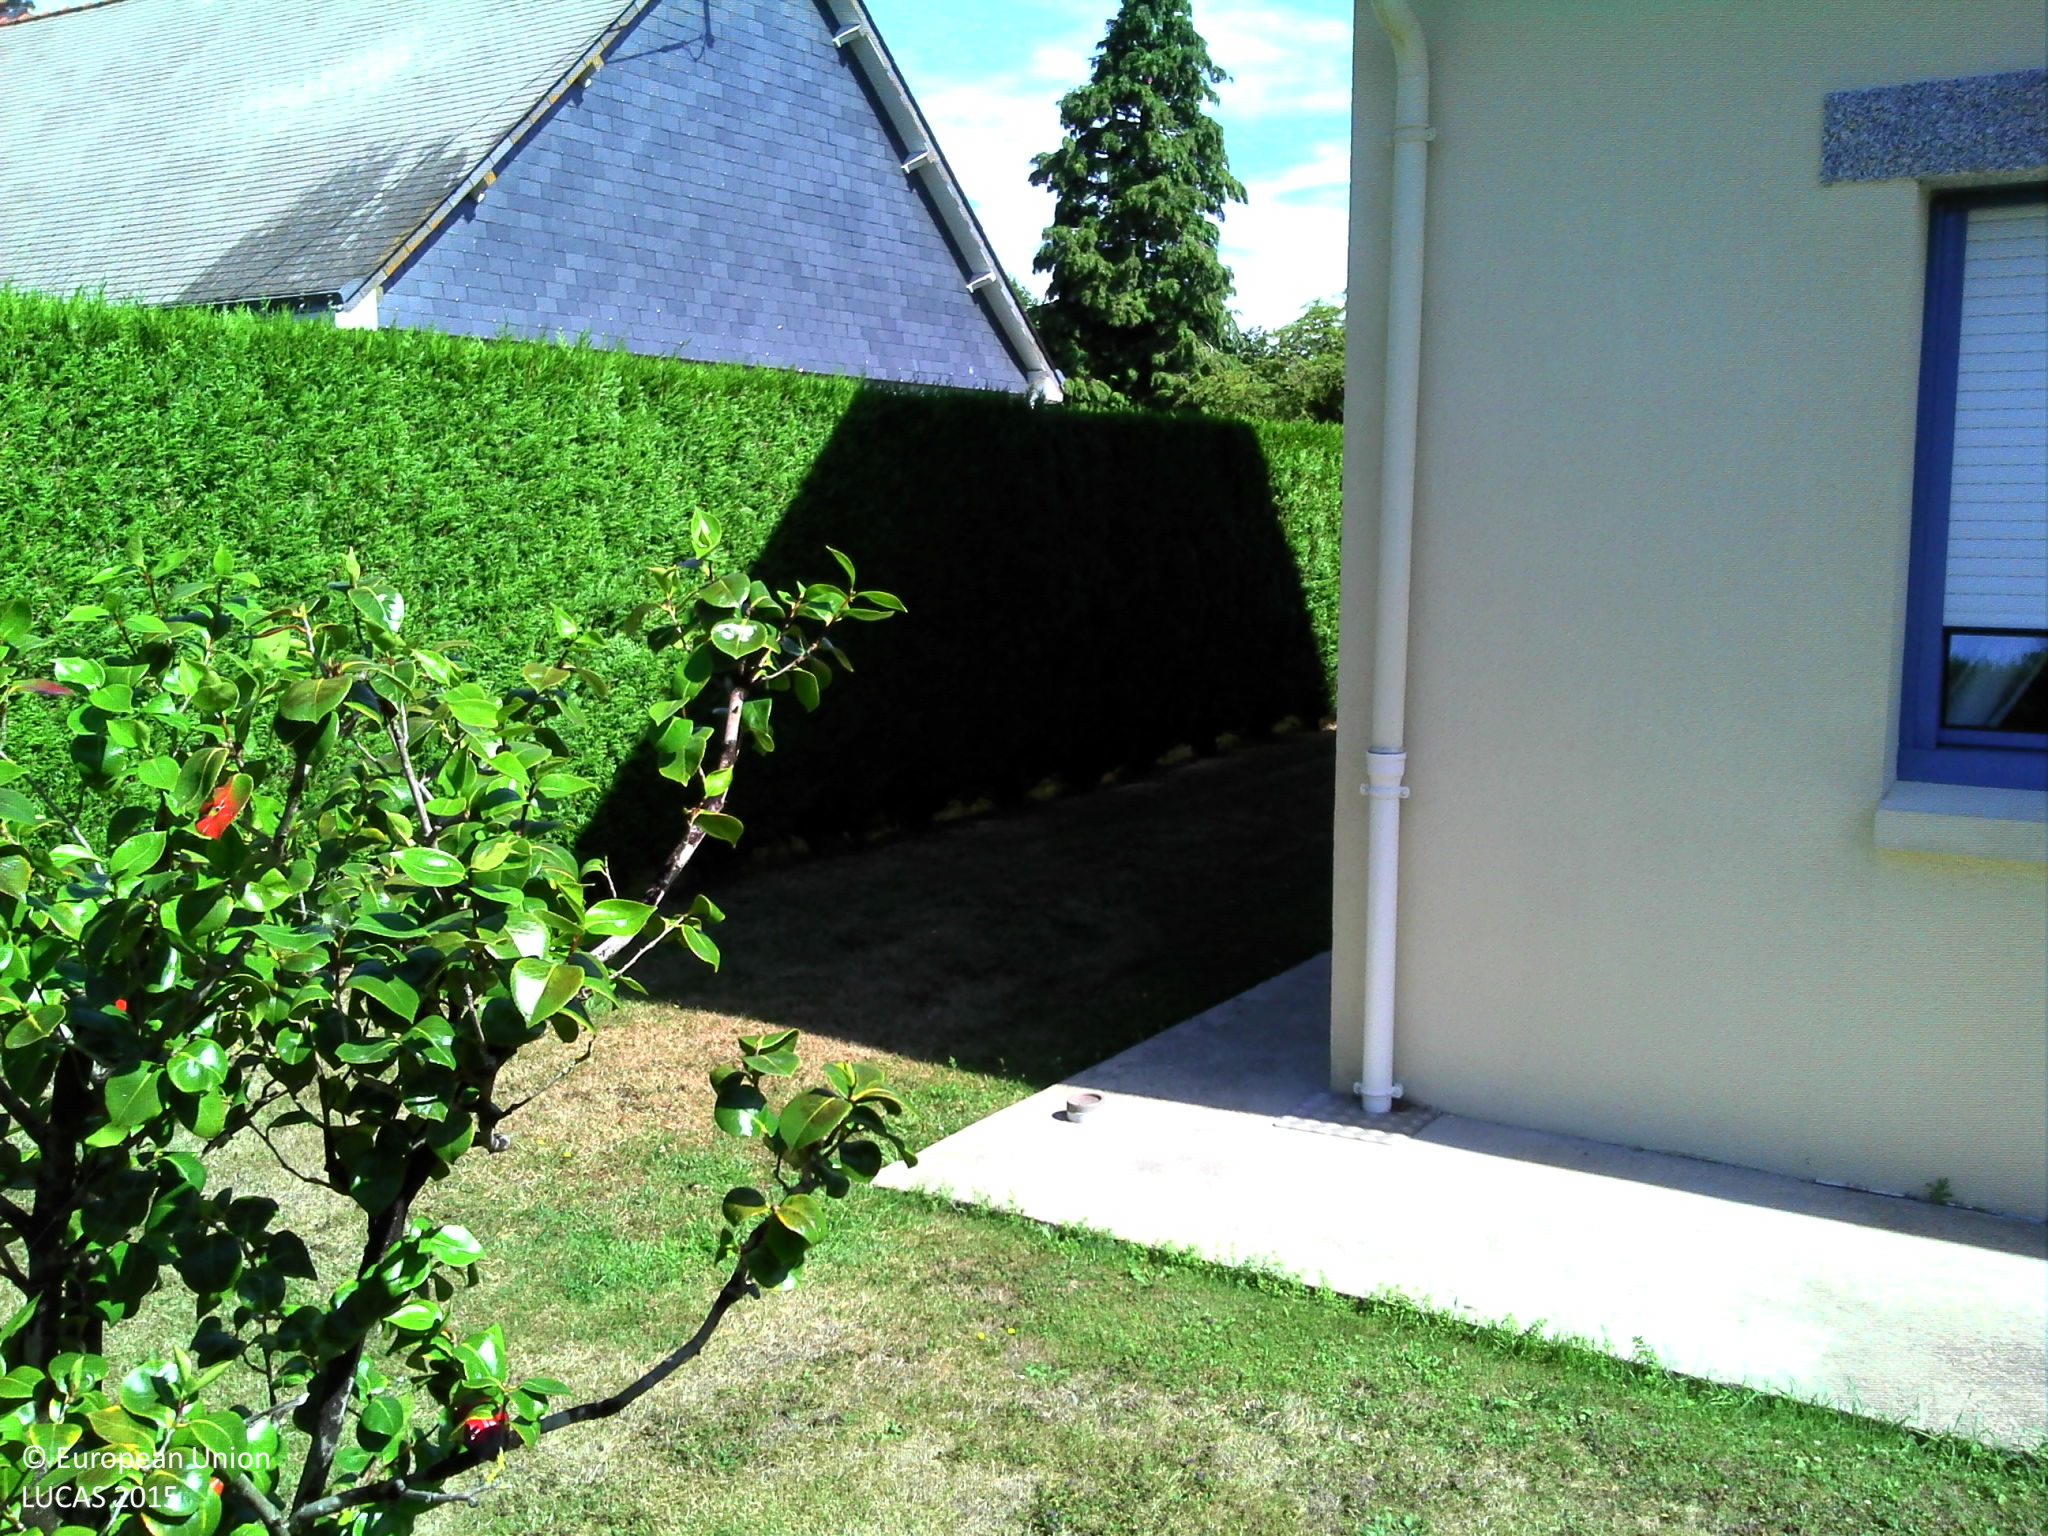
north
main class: Grassland
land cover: Grassland with sparse tree/shrub cover
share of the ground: > 75 %
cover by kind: herbaceous plants 95 %, broadleaved forest trees 5 %
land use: Residential
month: July
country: FR
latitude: 47.4445
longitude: -2.1053
